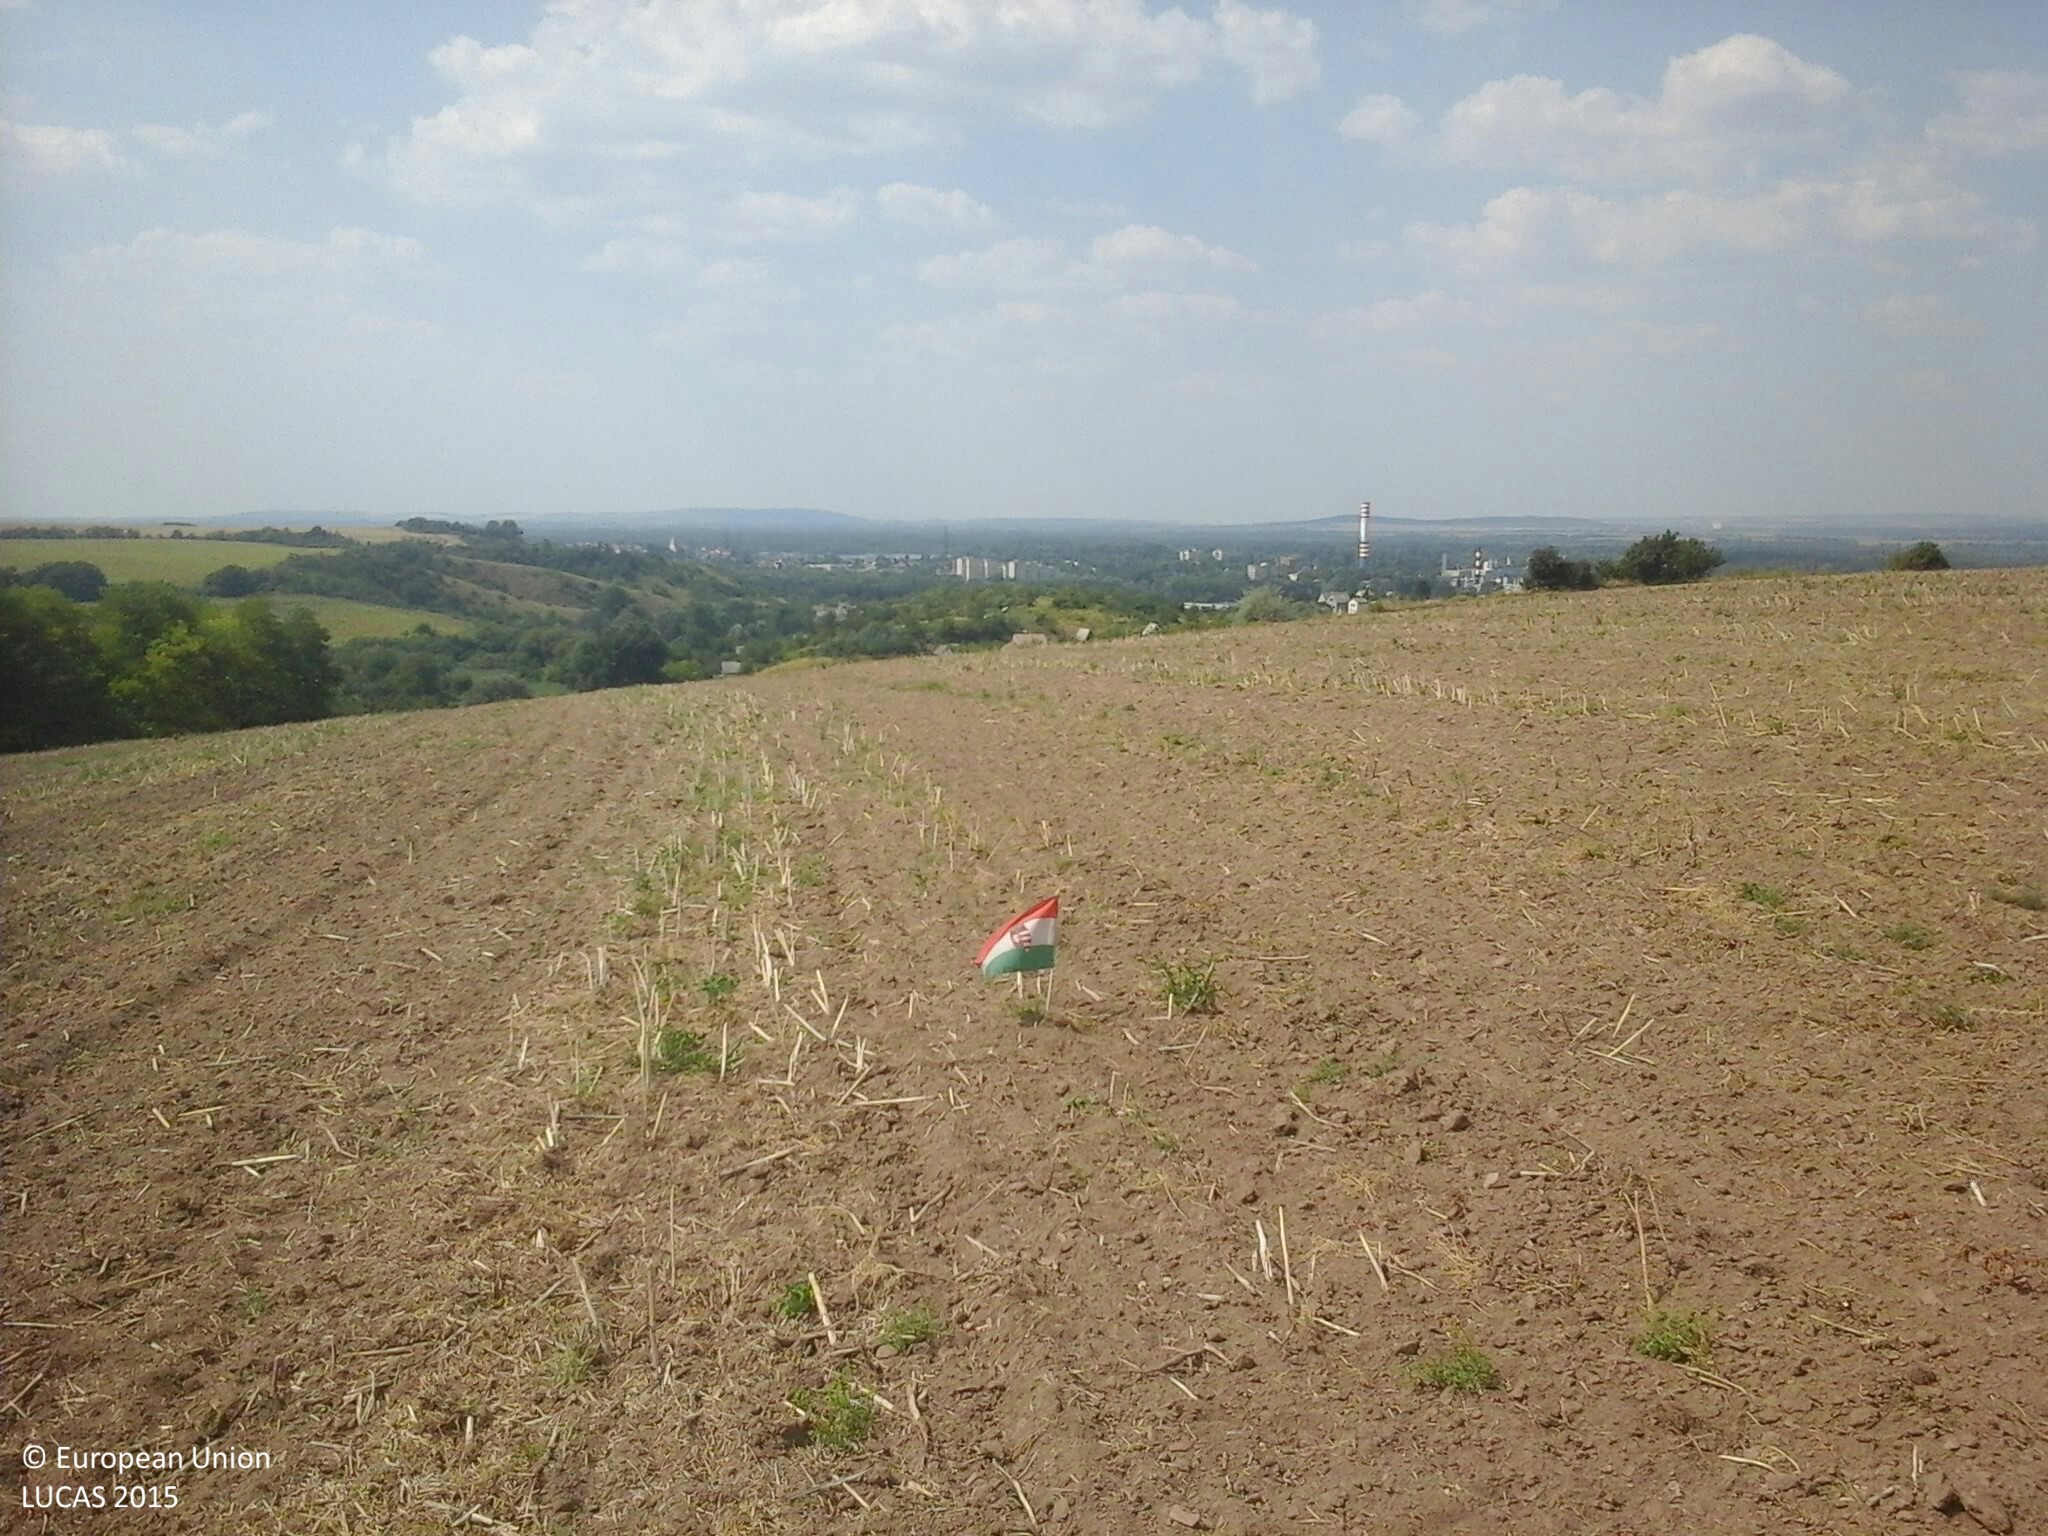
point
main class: Cropland
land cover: Rape and turnip rape
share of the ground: < 10 %
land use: Agriculture (excluding fallow land and kitchen gardens)
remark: Harvested field
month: August
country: HU
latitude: 47.7430
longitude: 18.5908
